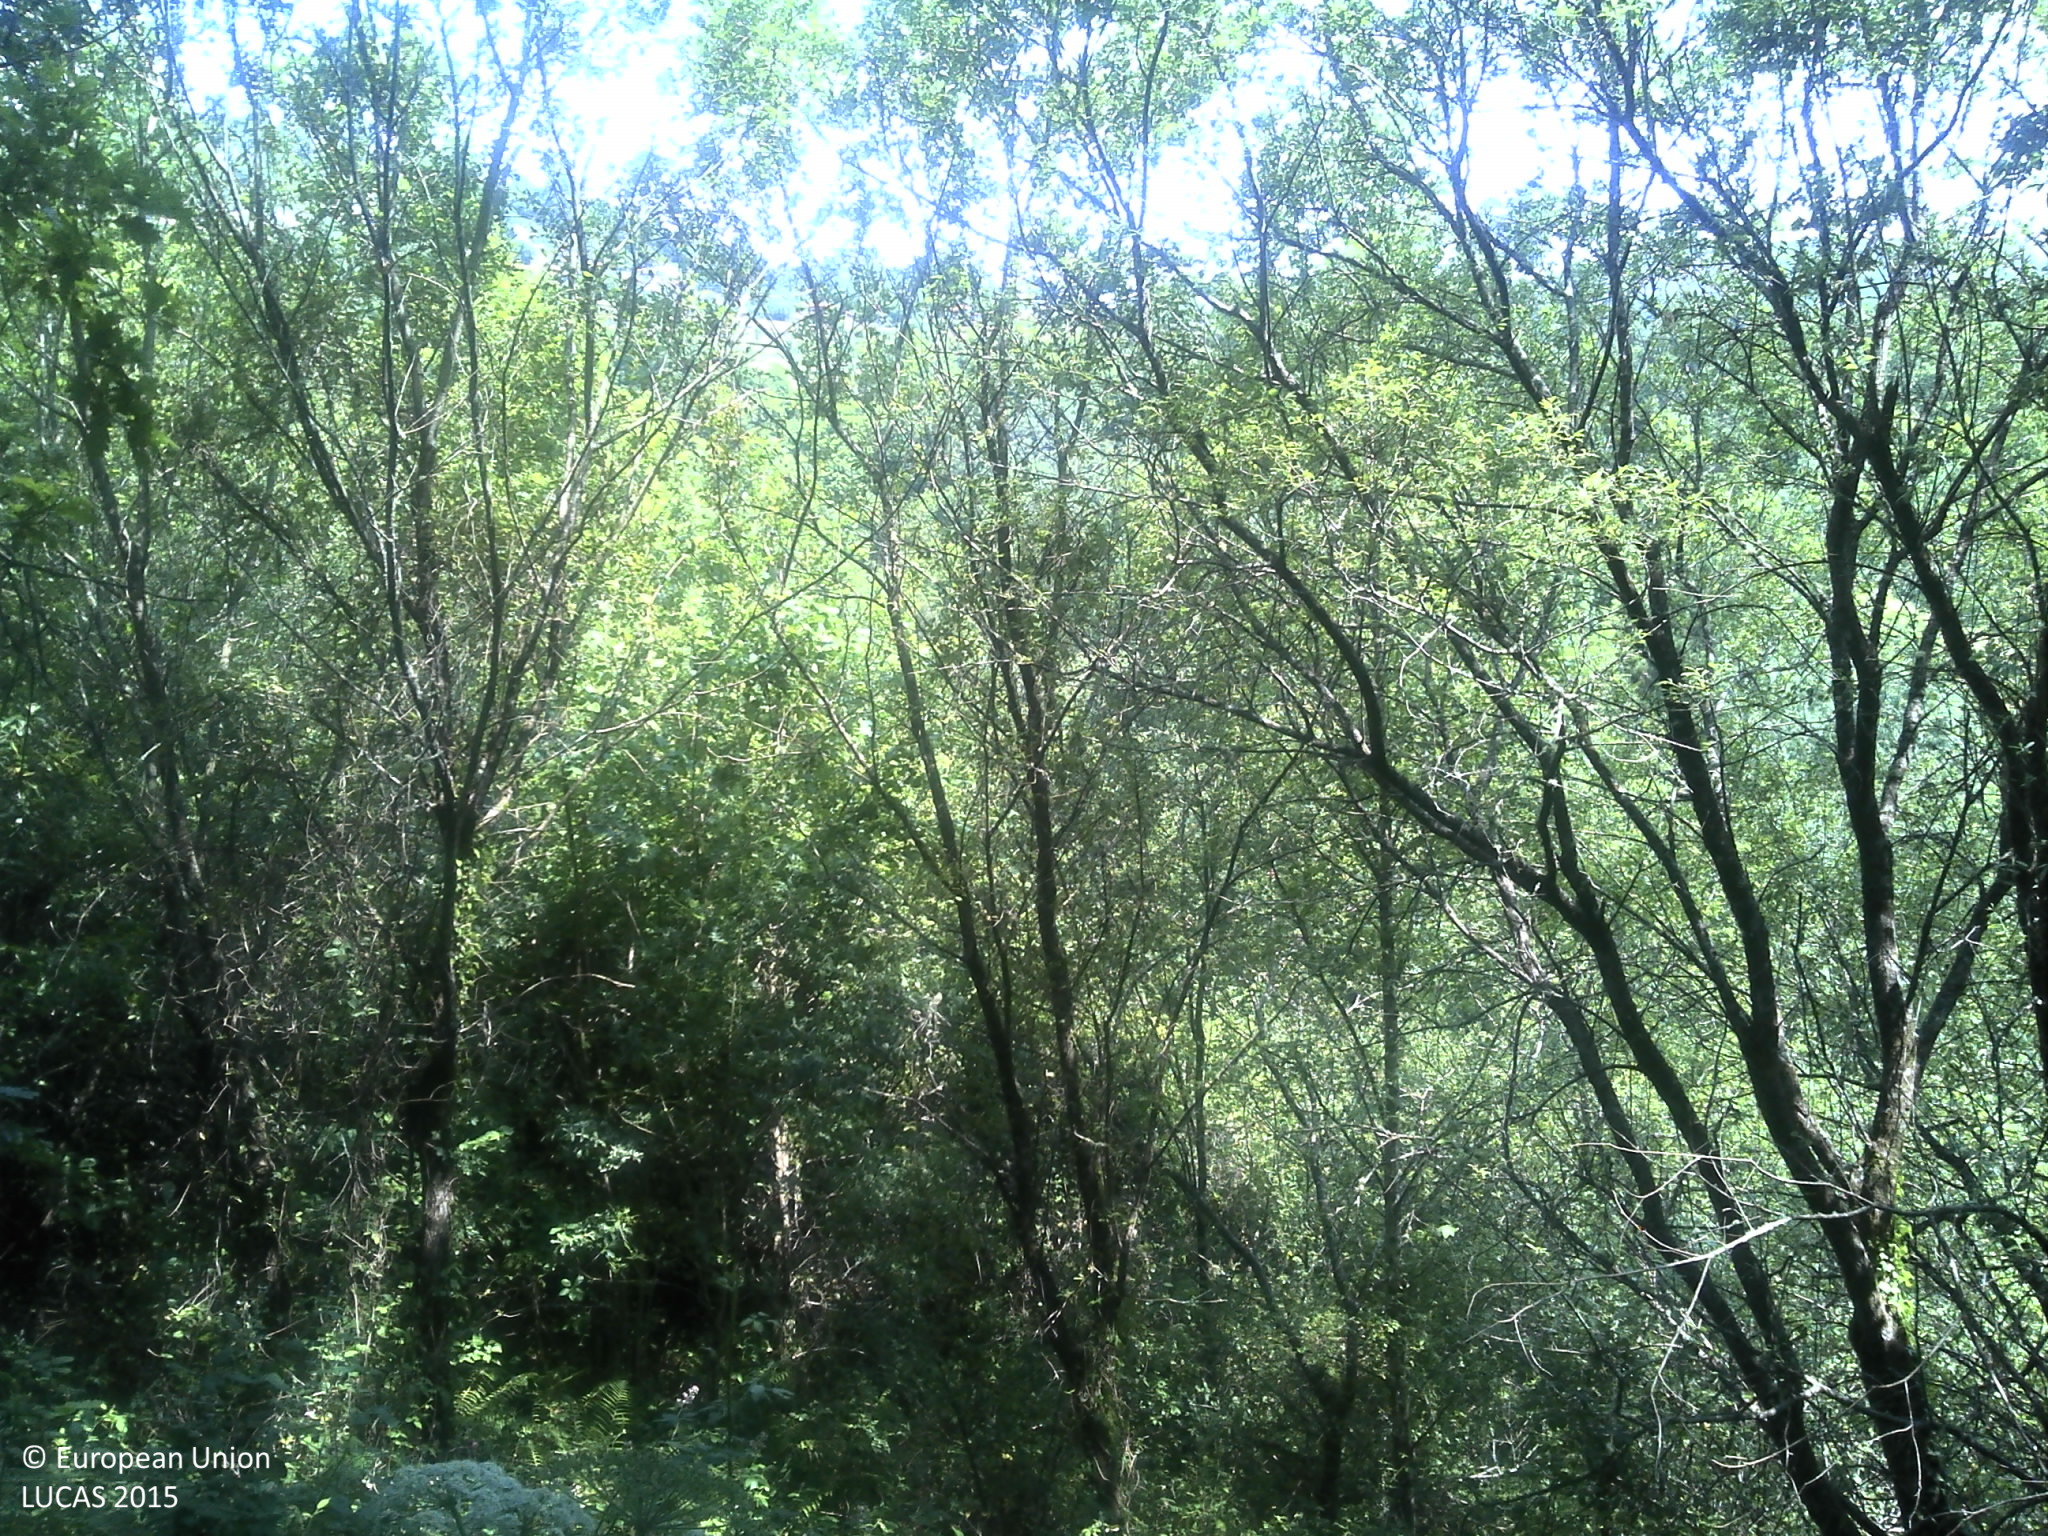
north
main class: Woodland
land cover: Broadleaved woodland
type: acidophilous oak and oak-birch forest
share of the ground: > 75 %
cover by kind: broadleaved forest trees 75 %, shrubs 10 %, herbaceous plants 10 %, unconsolidated bare surface 5 %
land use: Forestry
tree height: > 5 m
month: June
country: PT
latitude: 41.7414
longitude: -8.2235
